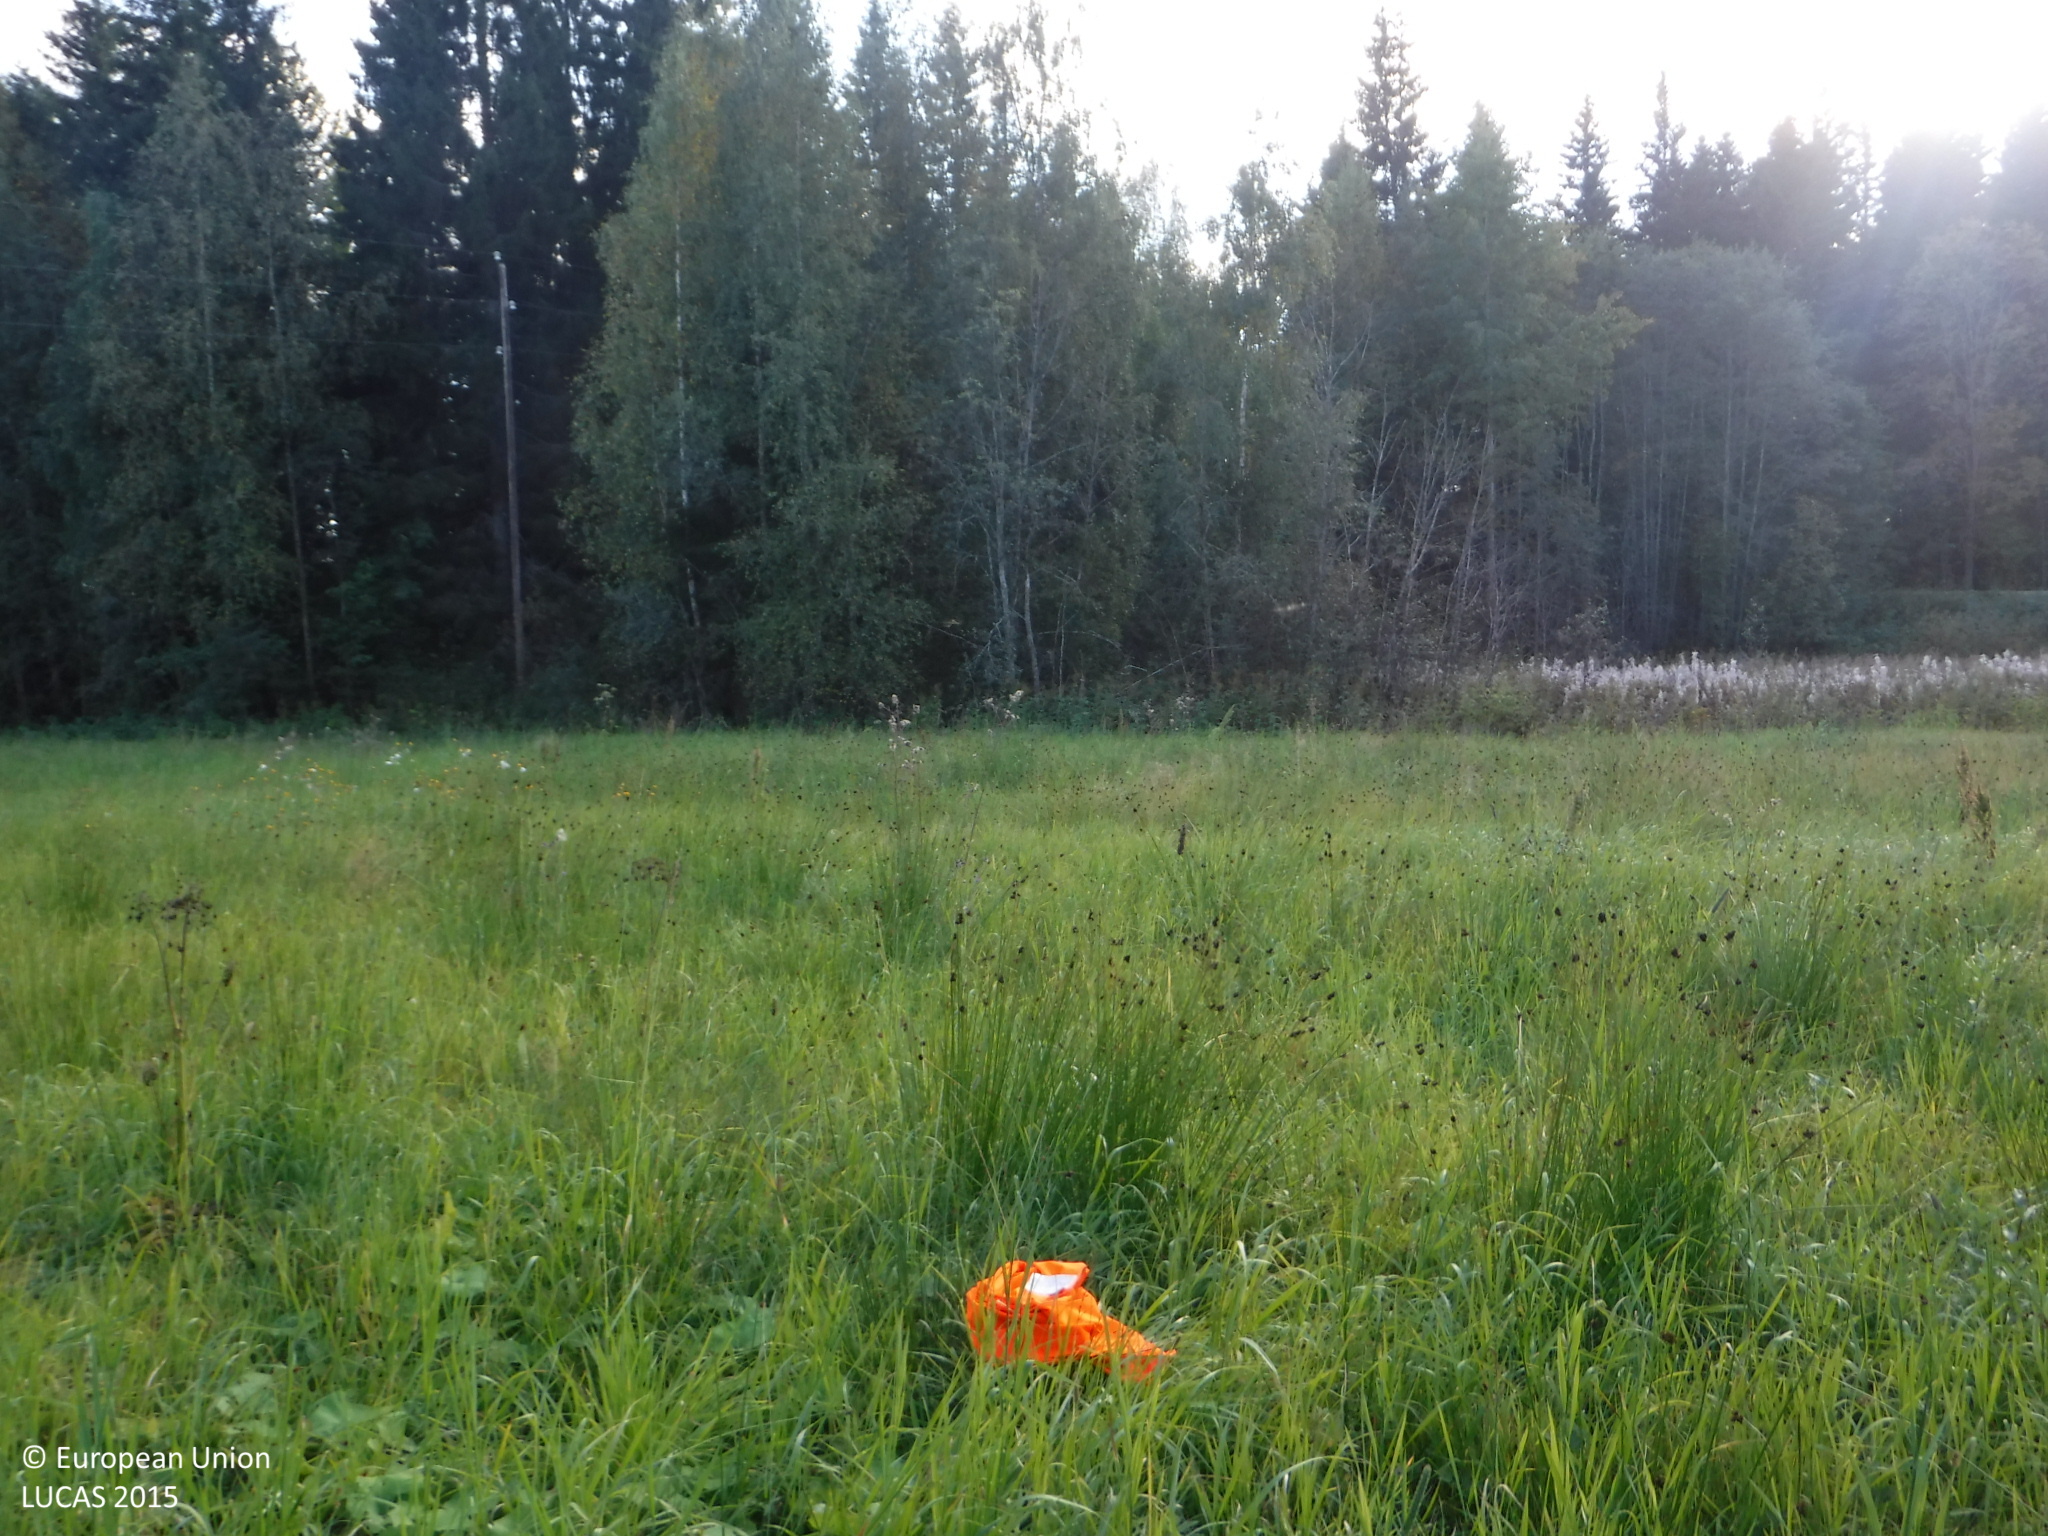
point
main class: Grassland
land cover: Grassland without tree/shrub cover
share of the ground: > 75 %
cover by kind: herbaceous plants 100 %
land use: Agriculture (excluding fallow land and kitchen gardens)
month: September
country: FI
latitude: 61.7686
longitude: 22.3966
